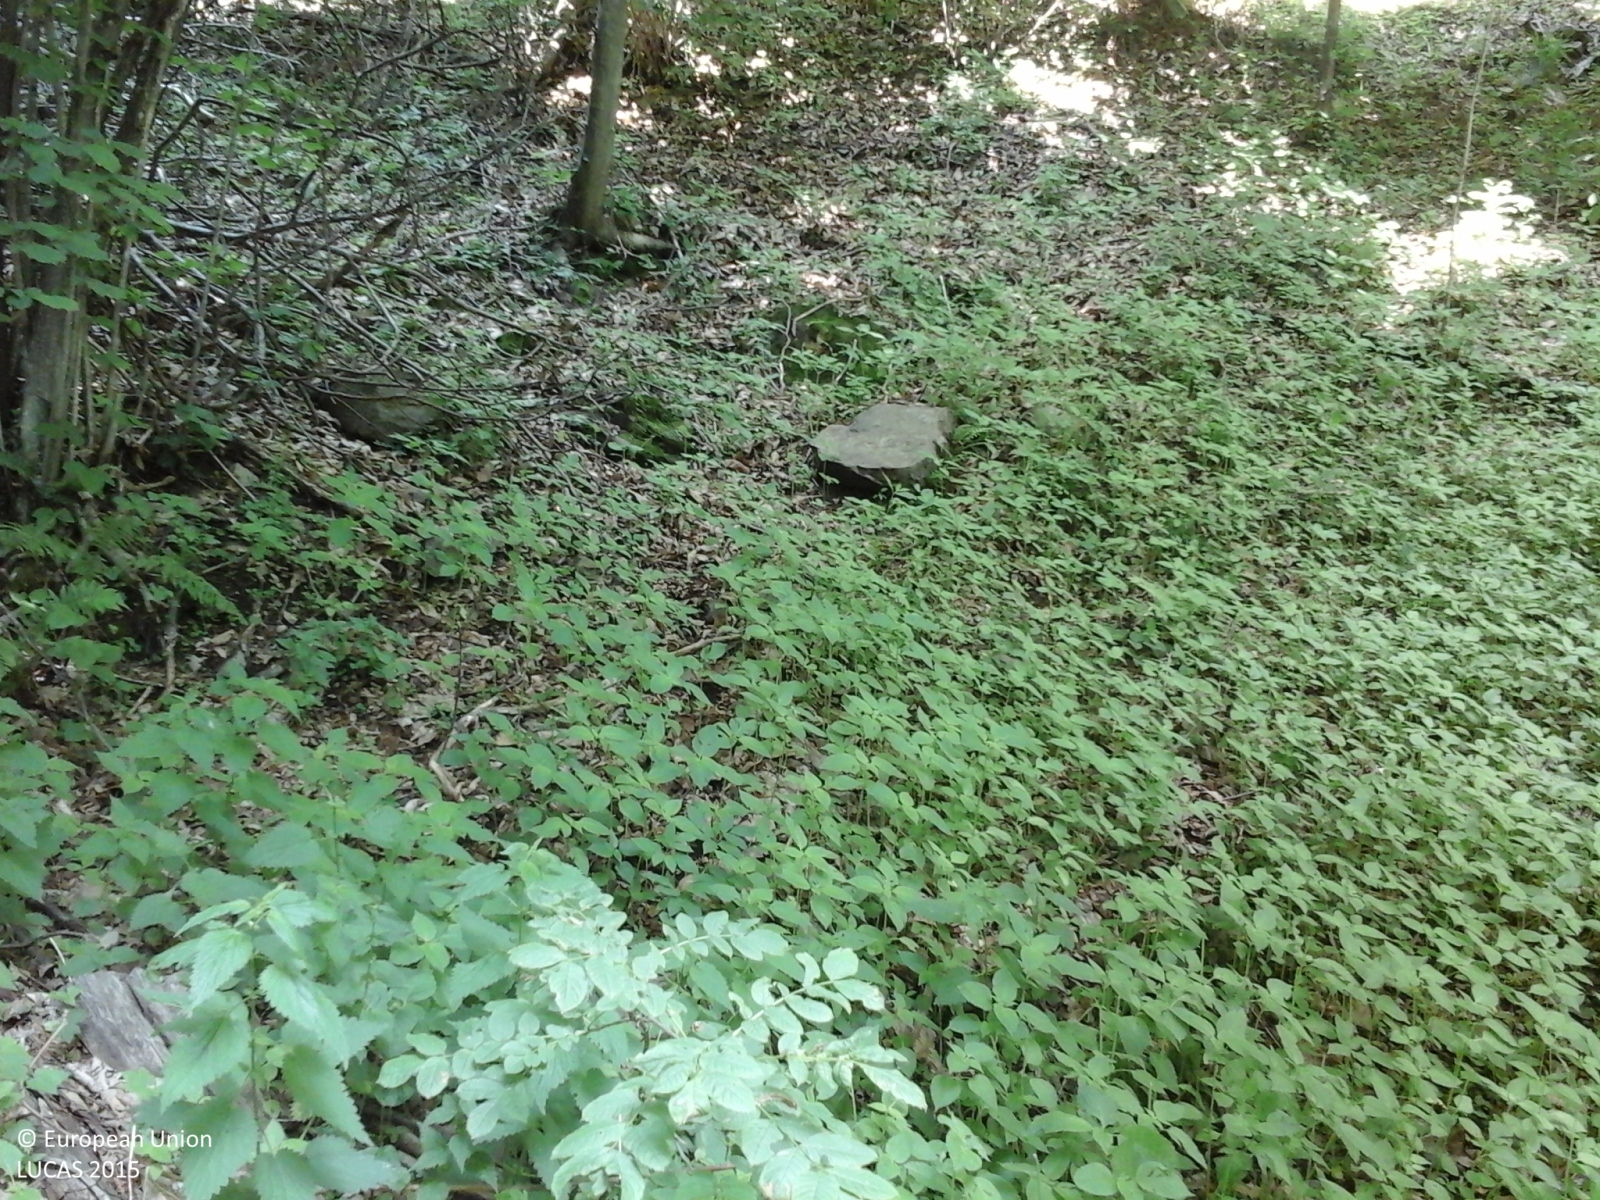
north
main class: Woodland
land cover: Broadleaved woodland
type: beech forest
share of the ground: > 75 %
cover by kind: broadleaved forest trees 100 %
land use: Forestry
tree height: > 5 m
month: June
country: IT
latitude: 45.8682
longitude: 8.2377
